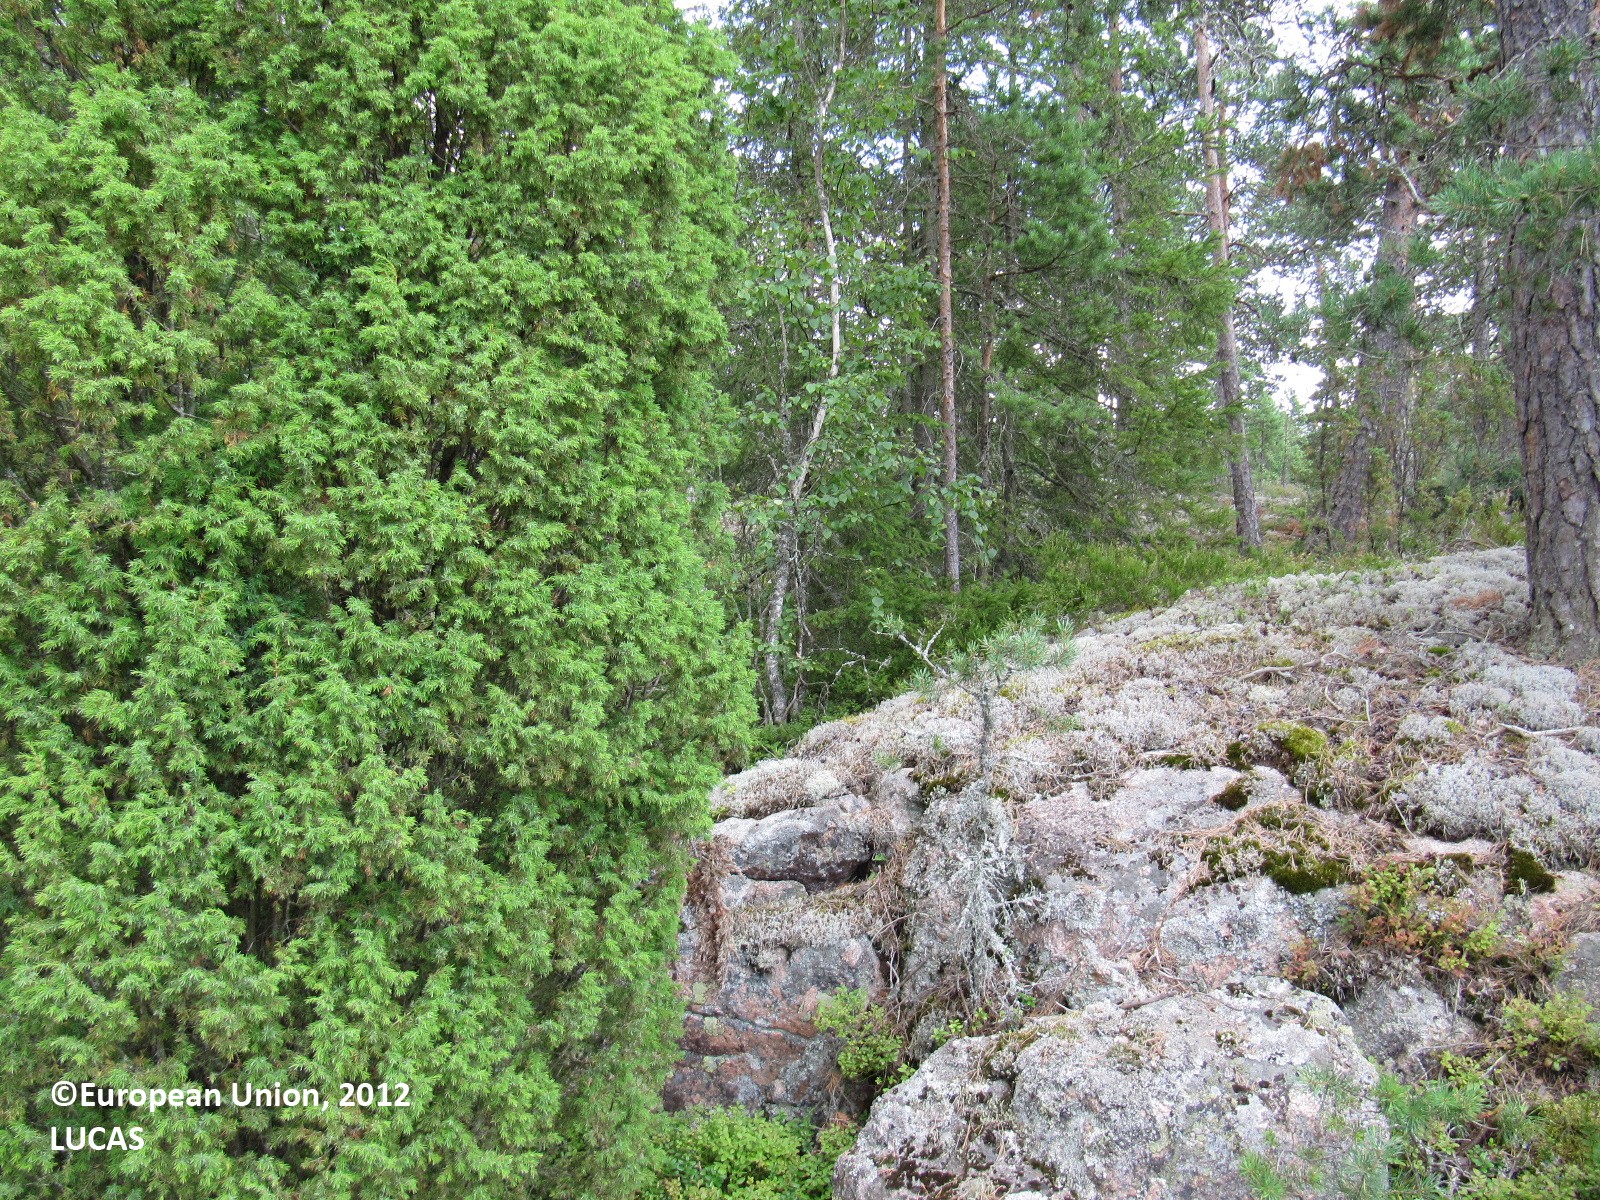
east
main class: Woodland
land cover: Pine dominated mixed woodland
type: boreal forest
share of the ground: 50 - 75 %
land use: Forestry
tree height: > 5 m
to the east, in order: Pine dominated mixed woodland; Grassland with sparse tree/shrub cover
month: August
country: FI
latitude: 60.3802
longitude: 23.1964
